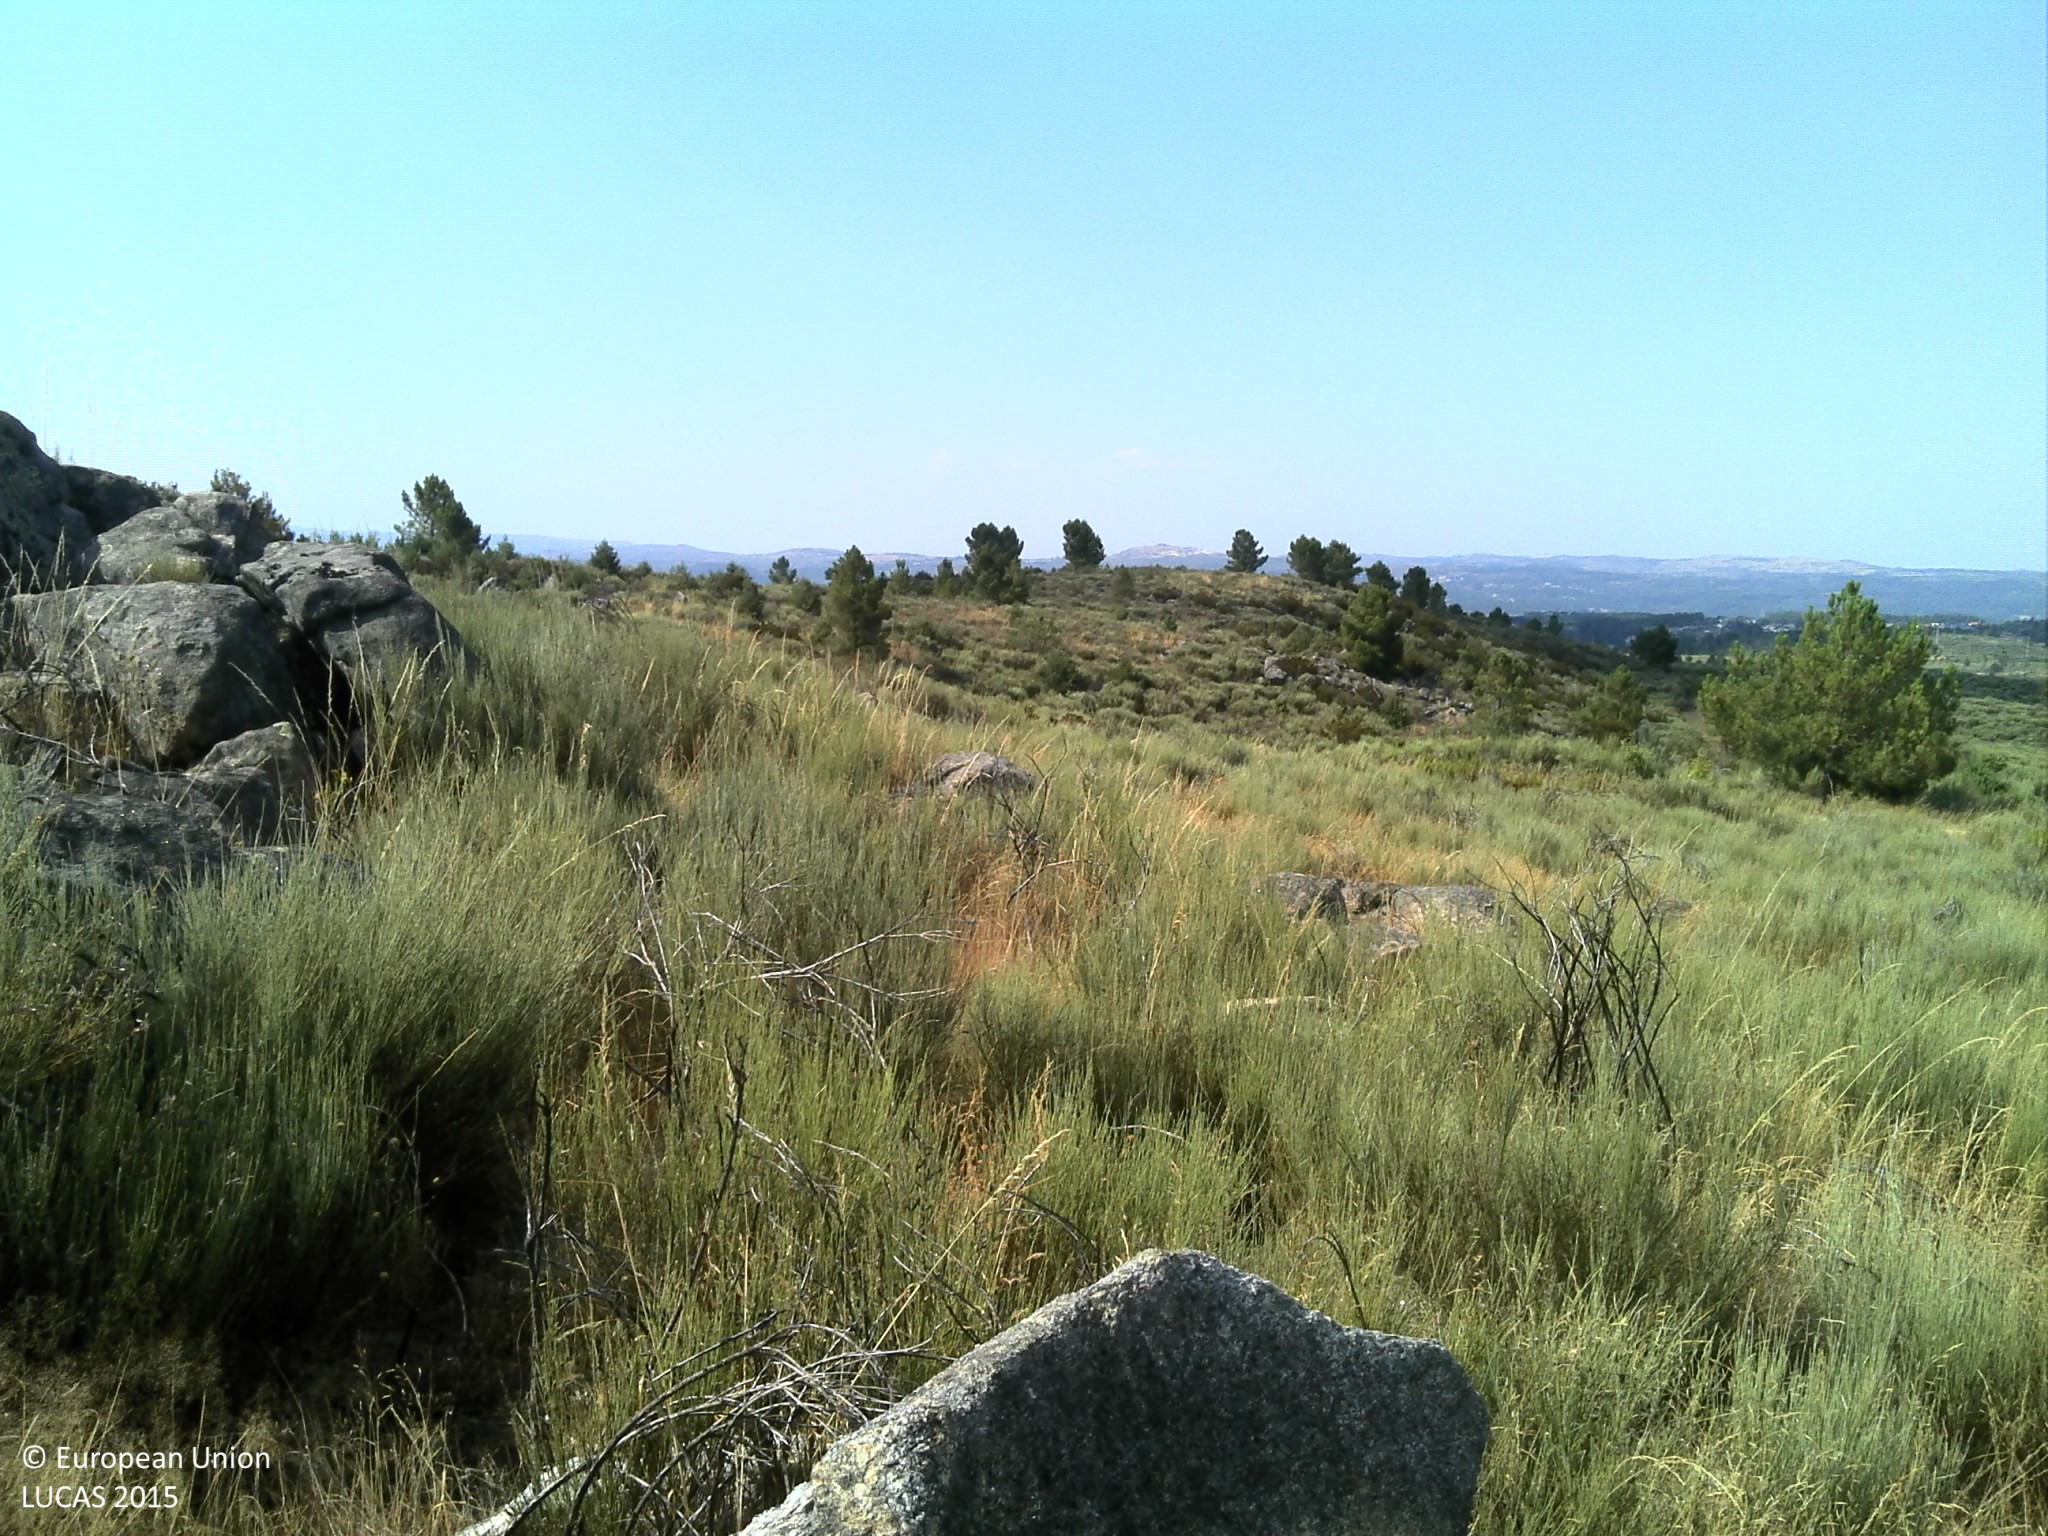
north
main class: Shrubland
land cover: Shrubland without tree cover
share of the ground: 50 - 75 %
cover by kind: shrubs 50 %, consolidated bare surface 20 %, herbaceous plants 15 %, unconsolidated bare surface 15 %
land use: Semi-natural and natural areas not in use
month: July
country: PT
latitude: 40.8806
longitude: -7.4783
